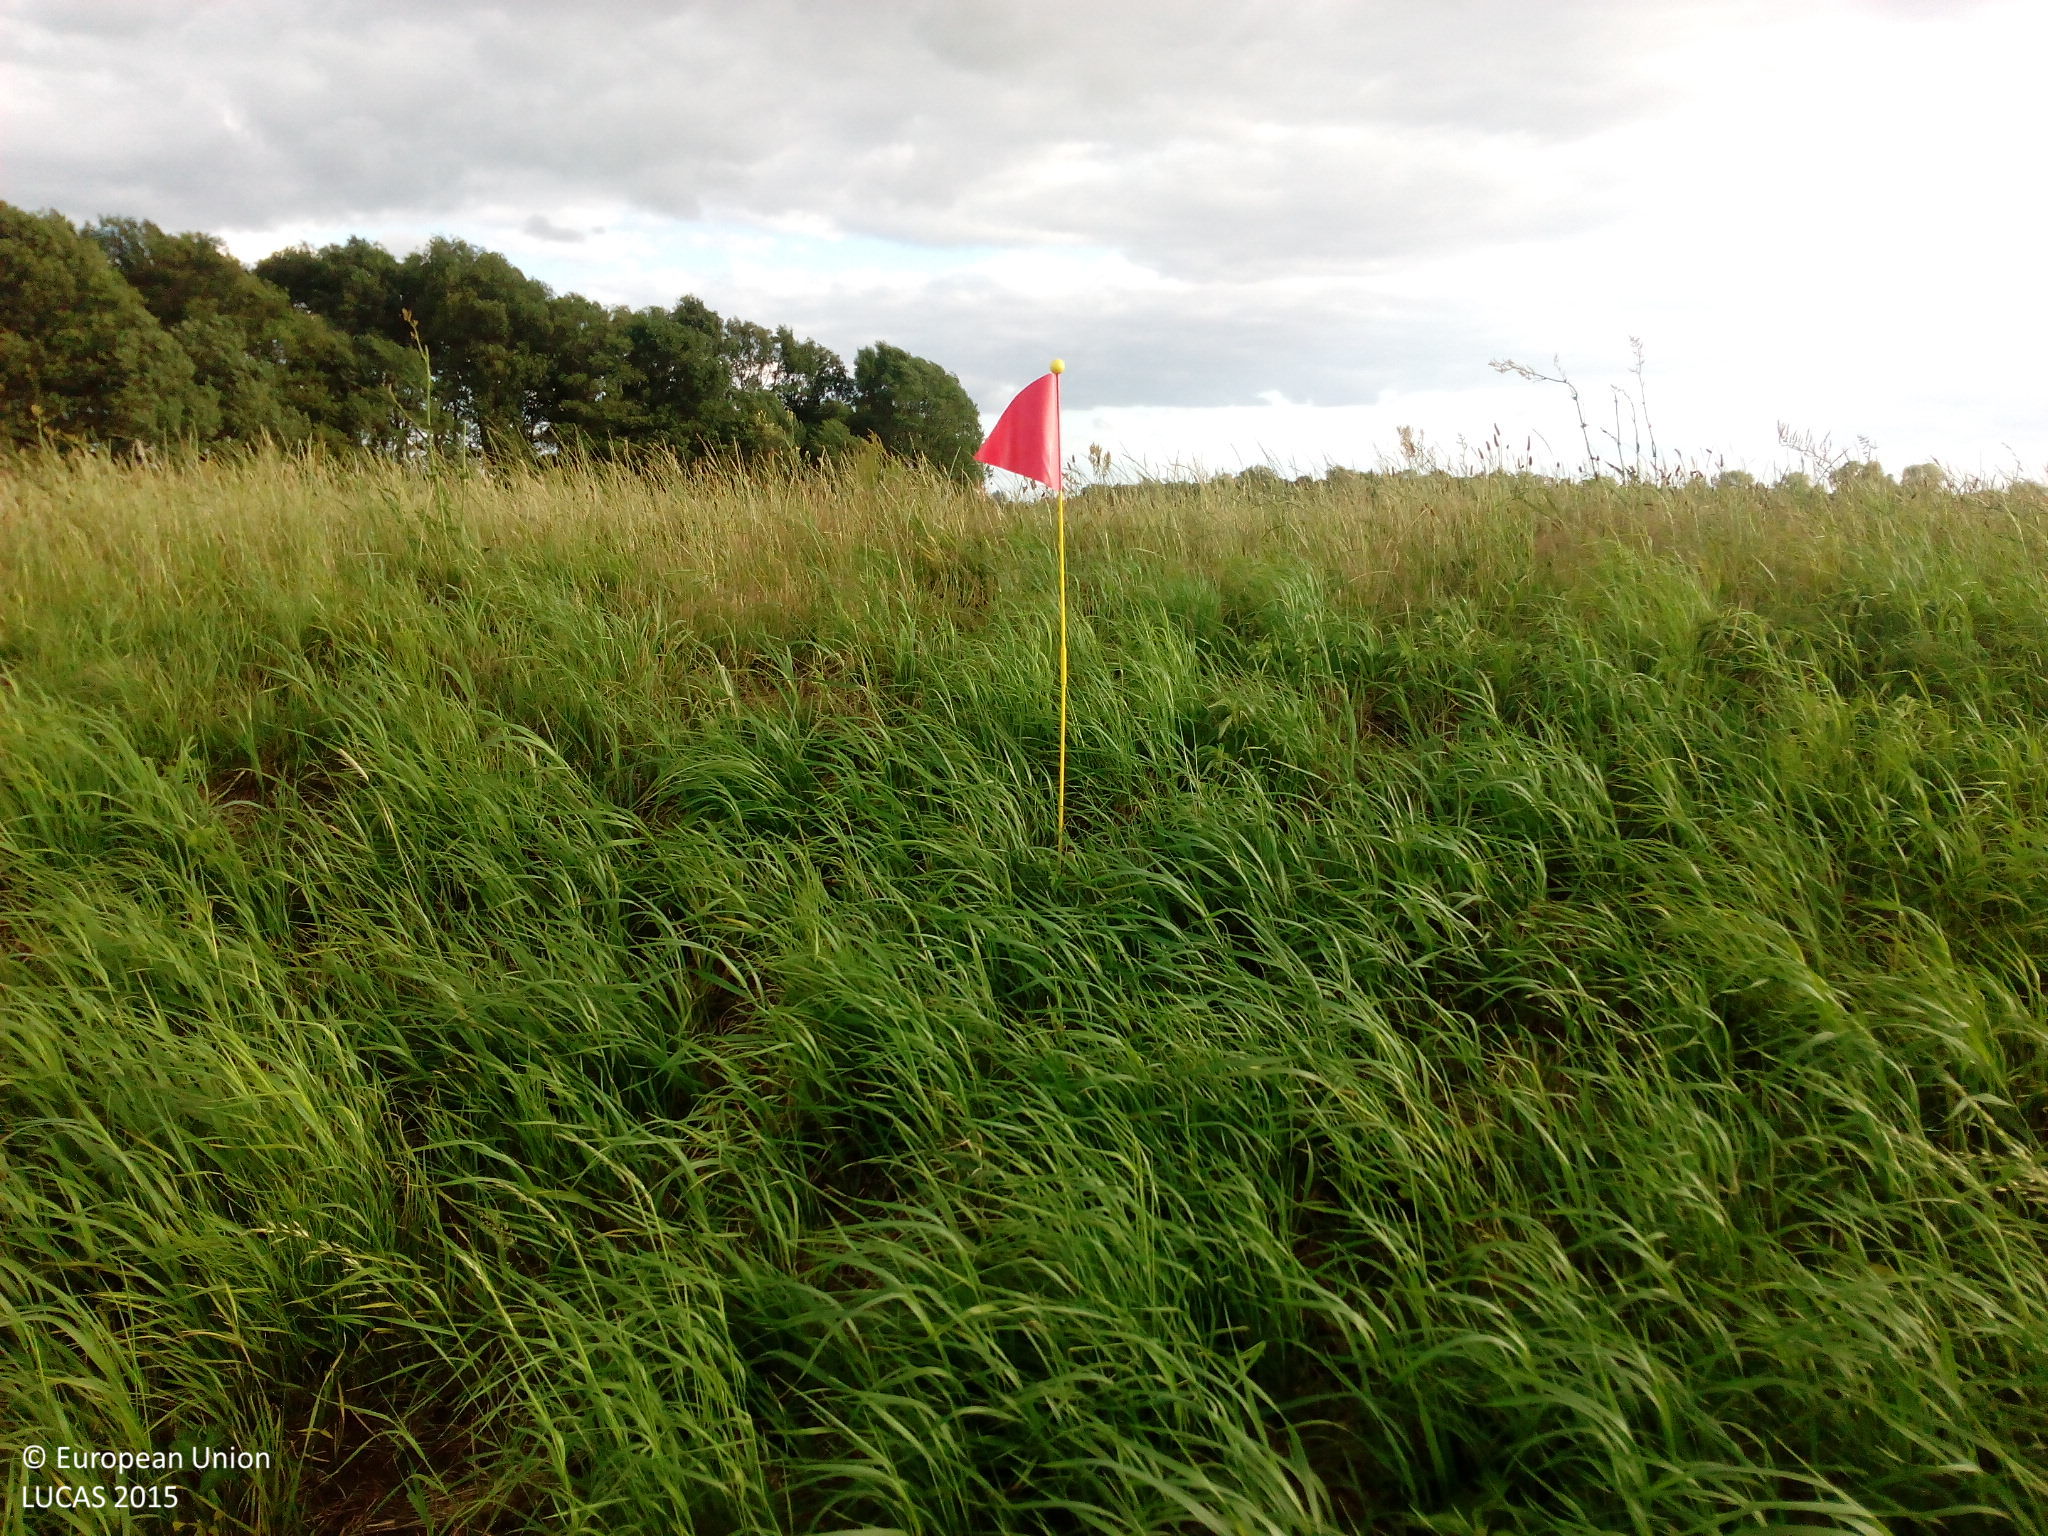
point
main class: Grassland
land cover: Grassland without tree/shrub cover
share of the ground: > 75 %
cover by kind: herbaceous plants 100 %
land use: Protection infrastructures
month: July
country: DE
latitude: 52.7862
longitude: 12.3274
